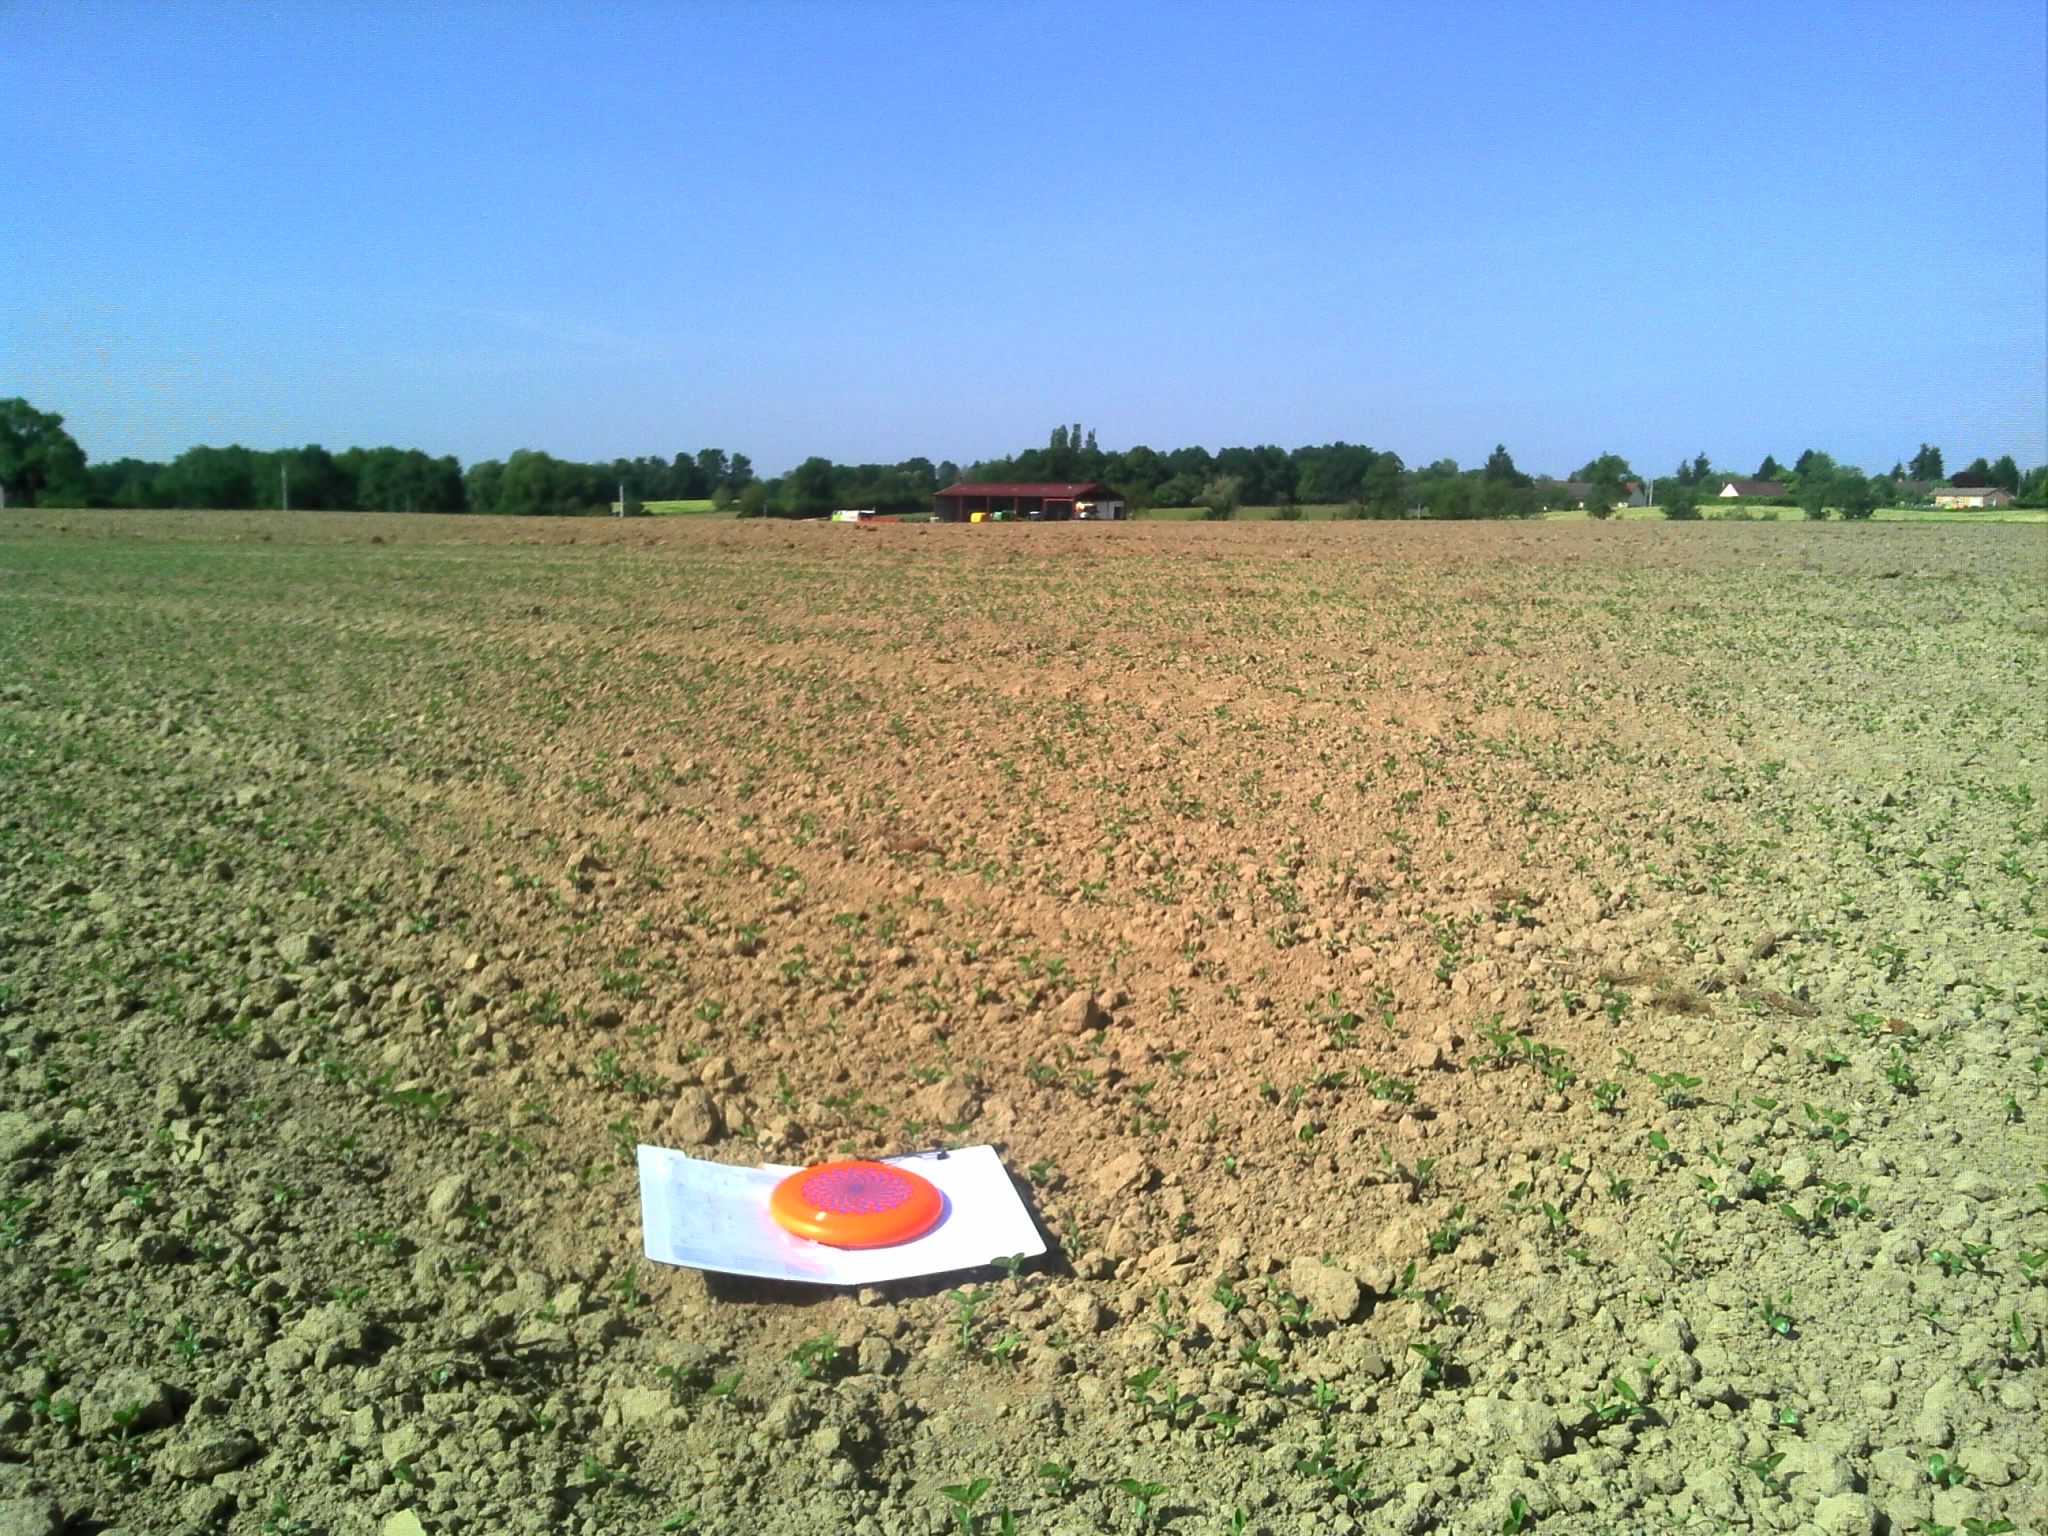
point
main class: Cropland
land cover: Soya
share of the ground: < 10 %
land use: Agriculture (excluding fallow land and kitchen gardens)
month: May
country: FR
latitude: 46.5606
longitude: 5.0320
